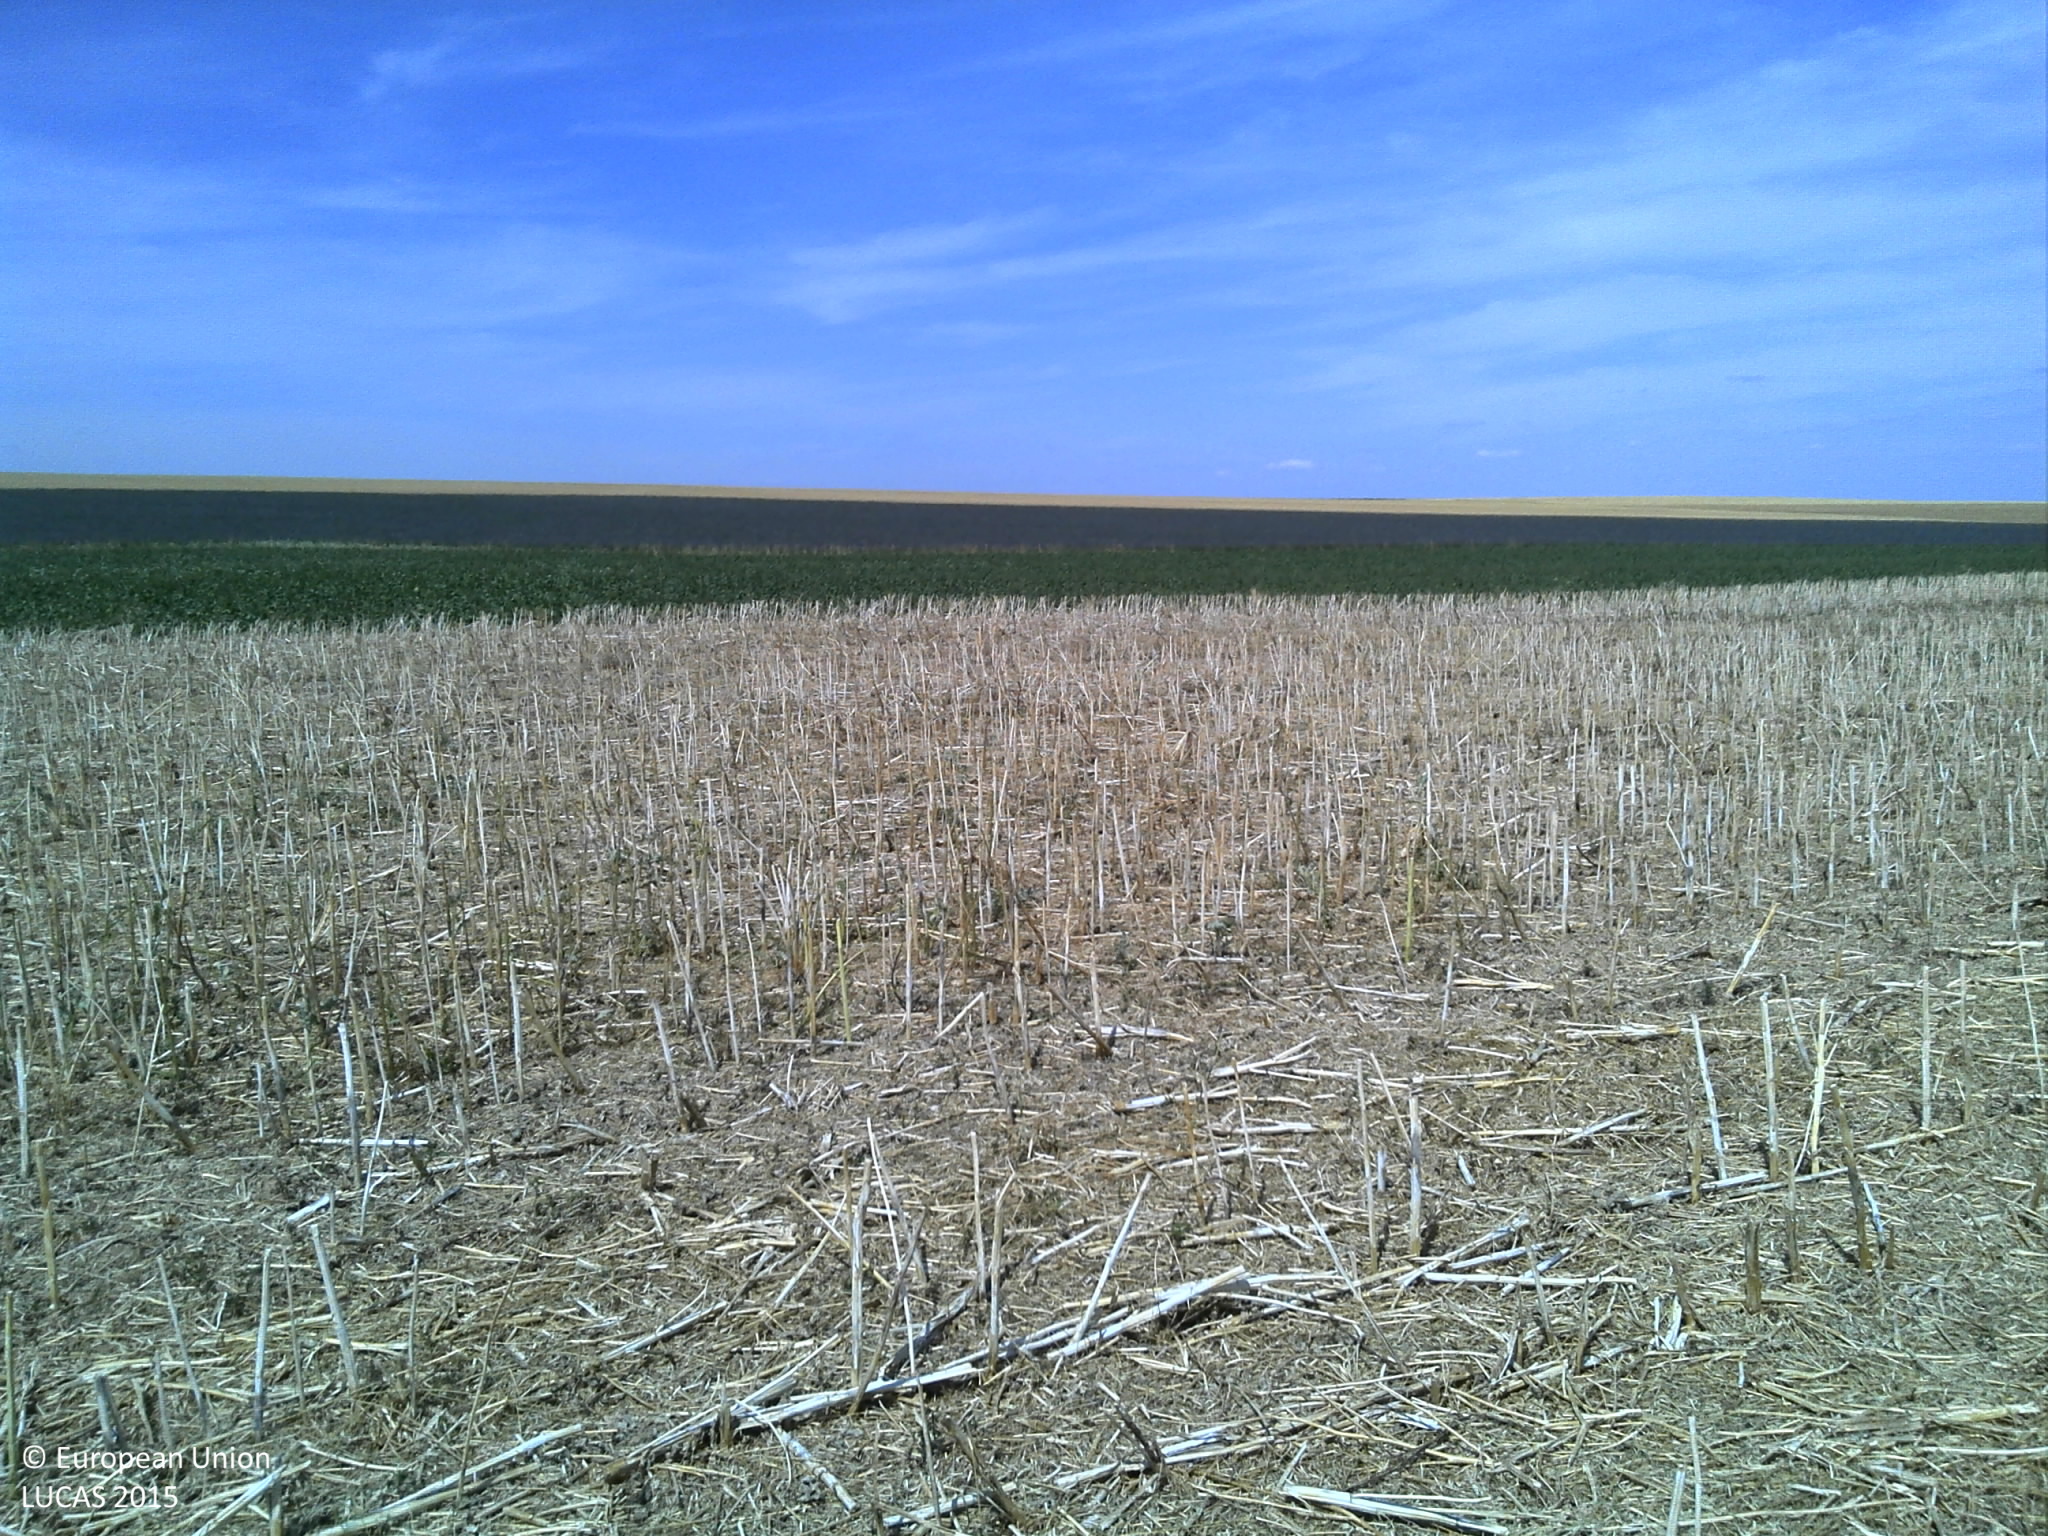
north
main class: Cropland
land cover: Rape and turnip rape
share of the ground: > 75 %
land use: Agriculture (excluding fallow land and kitchen gardens)
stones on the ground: < 10 %
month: August
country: FR
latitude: 48.9967
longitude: 4.6803
